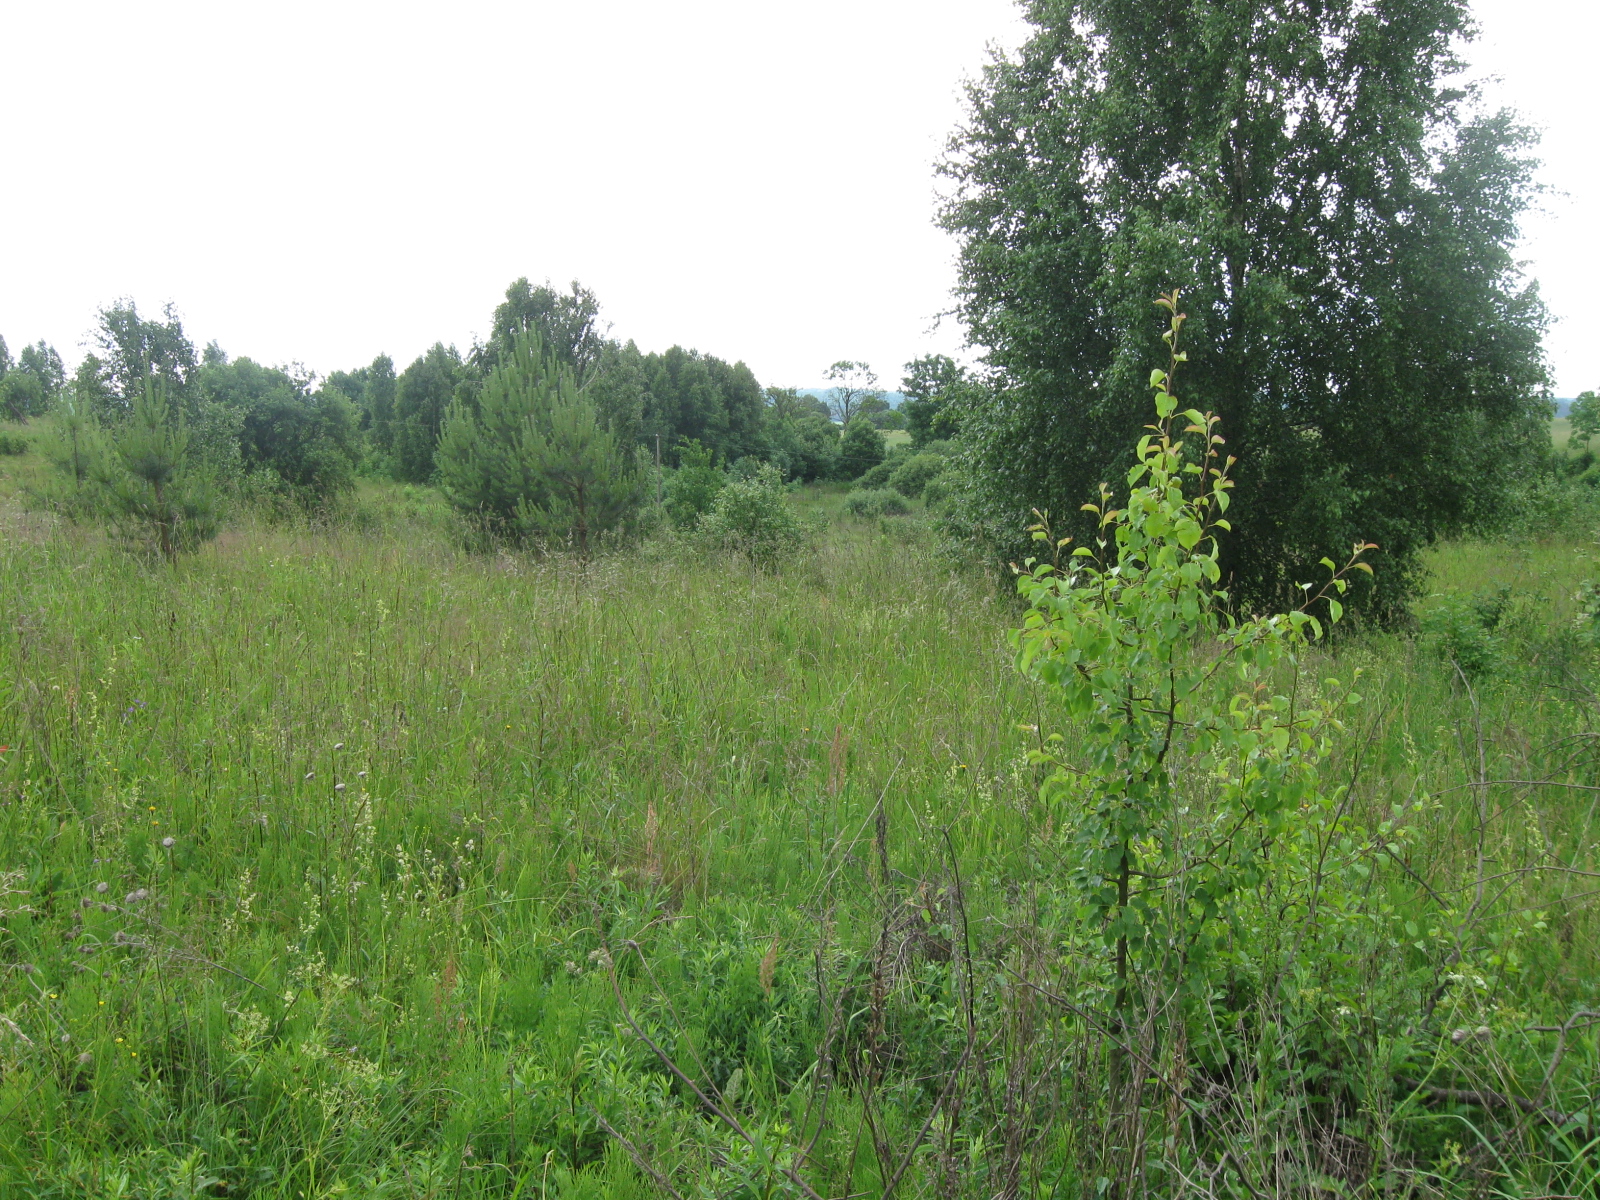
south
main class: Grassland
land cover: Grassland with sparse tree/shrub cover
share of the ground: > 75 %
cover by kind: herbaceous plants 90 %, broadleaved forest trees 5 %, shrubs 5 %
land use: Agriculture (excluding fallow land and kitchen gardens)
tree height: < 5 m
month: June
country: LT
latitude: 54.5638
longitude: 24.4064
